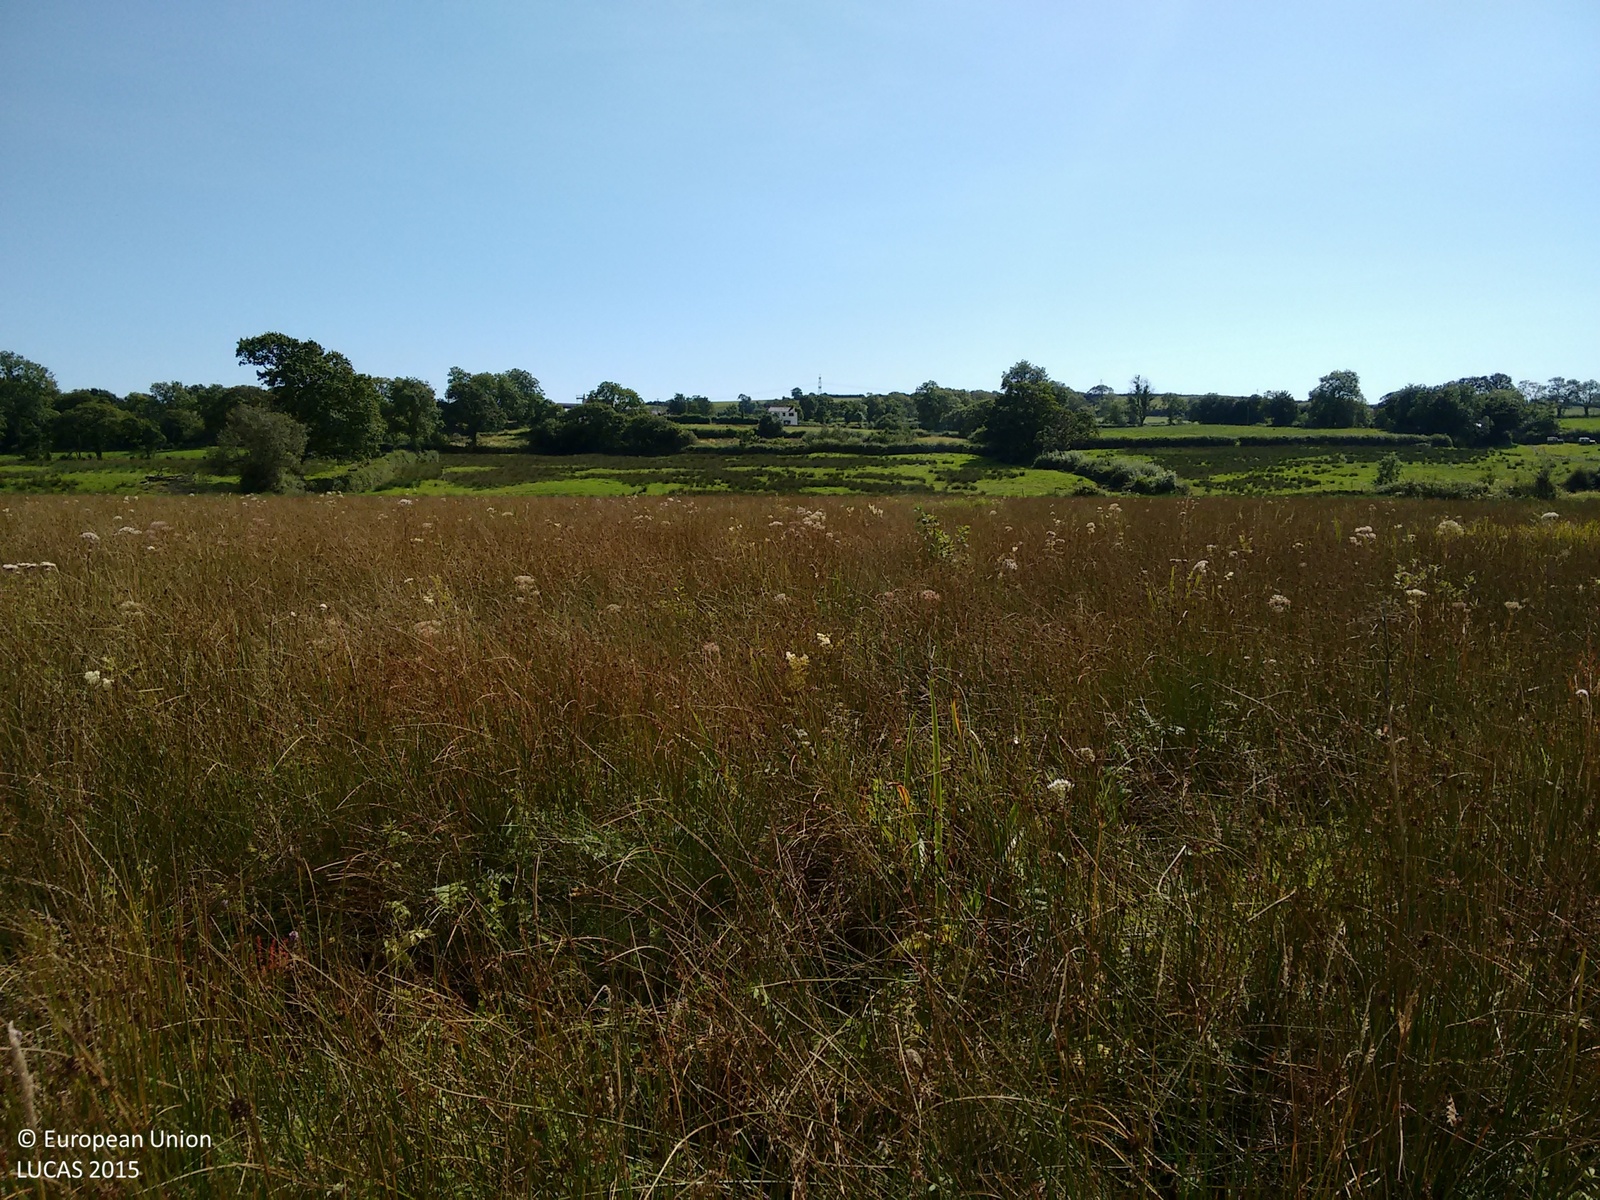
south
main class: Grassland
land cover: Grassland without tree/shrub cover
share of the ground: > 75 %
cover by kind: herbaceous plants 95 %, unconsolidated bare surface 5 %
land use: Agriculture (excluding fallow land and kitchen gardens)
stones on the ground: < 10 %
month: August
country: GB
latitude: 51.8087
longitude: -4.5081
